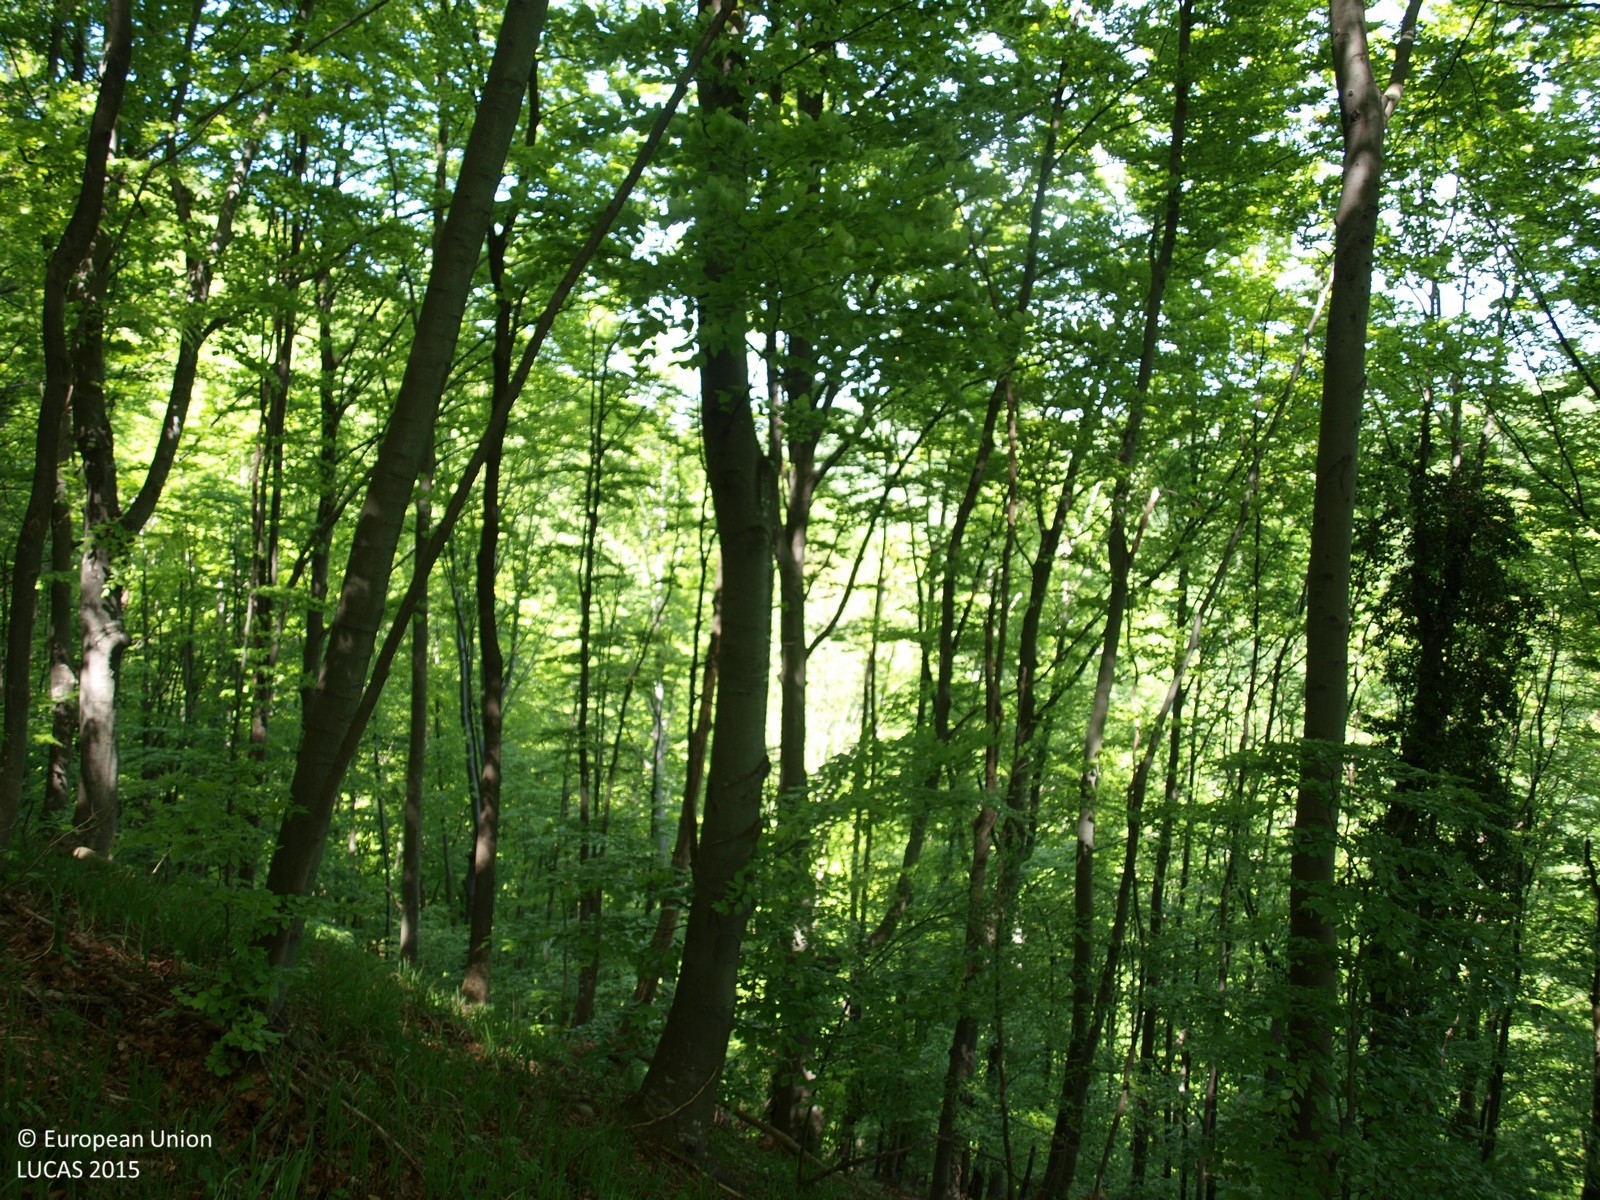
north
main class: Woodland
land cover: Broadleaved woodland
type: beech forest
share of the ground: > 75 %
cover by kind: broadleaved forest trees 100 %
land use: Forestry
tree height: > 5 m
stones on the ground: < 10 %
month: April
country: HR
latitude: 46.2712
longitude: 16.0331
